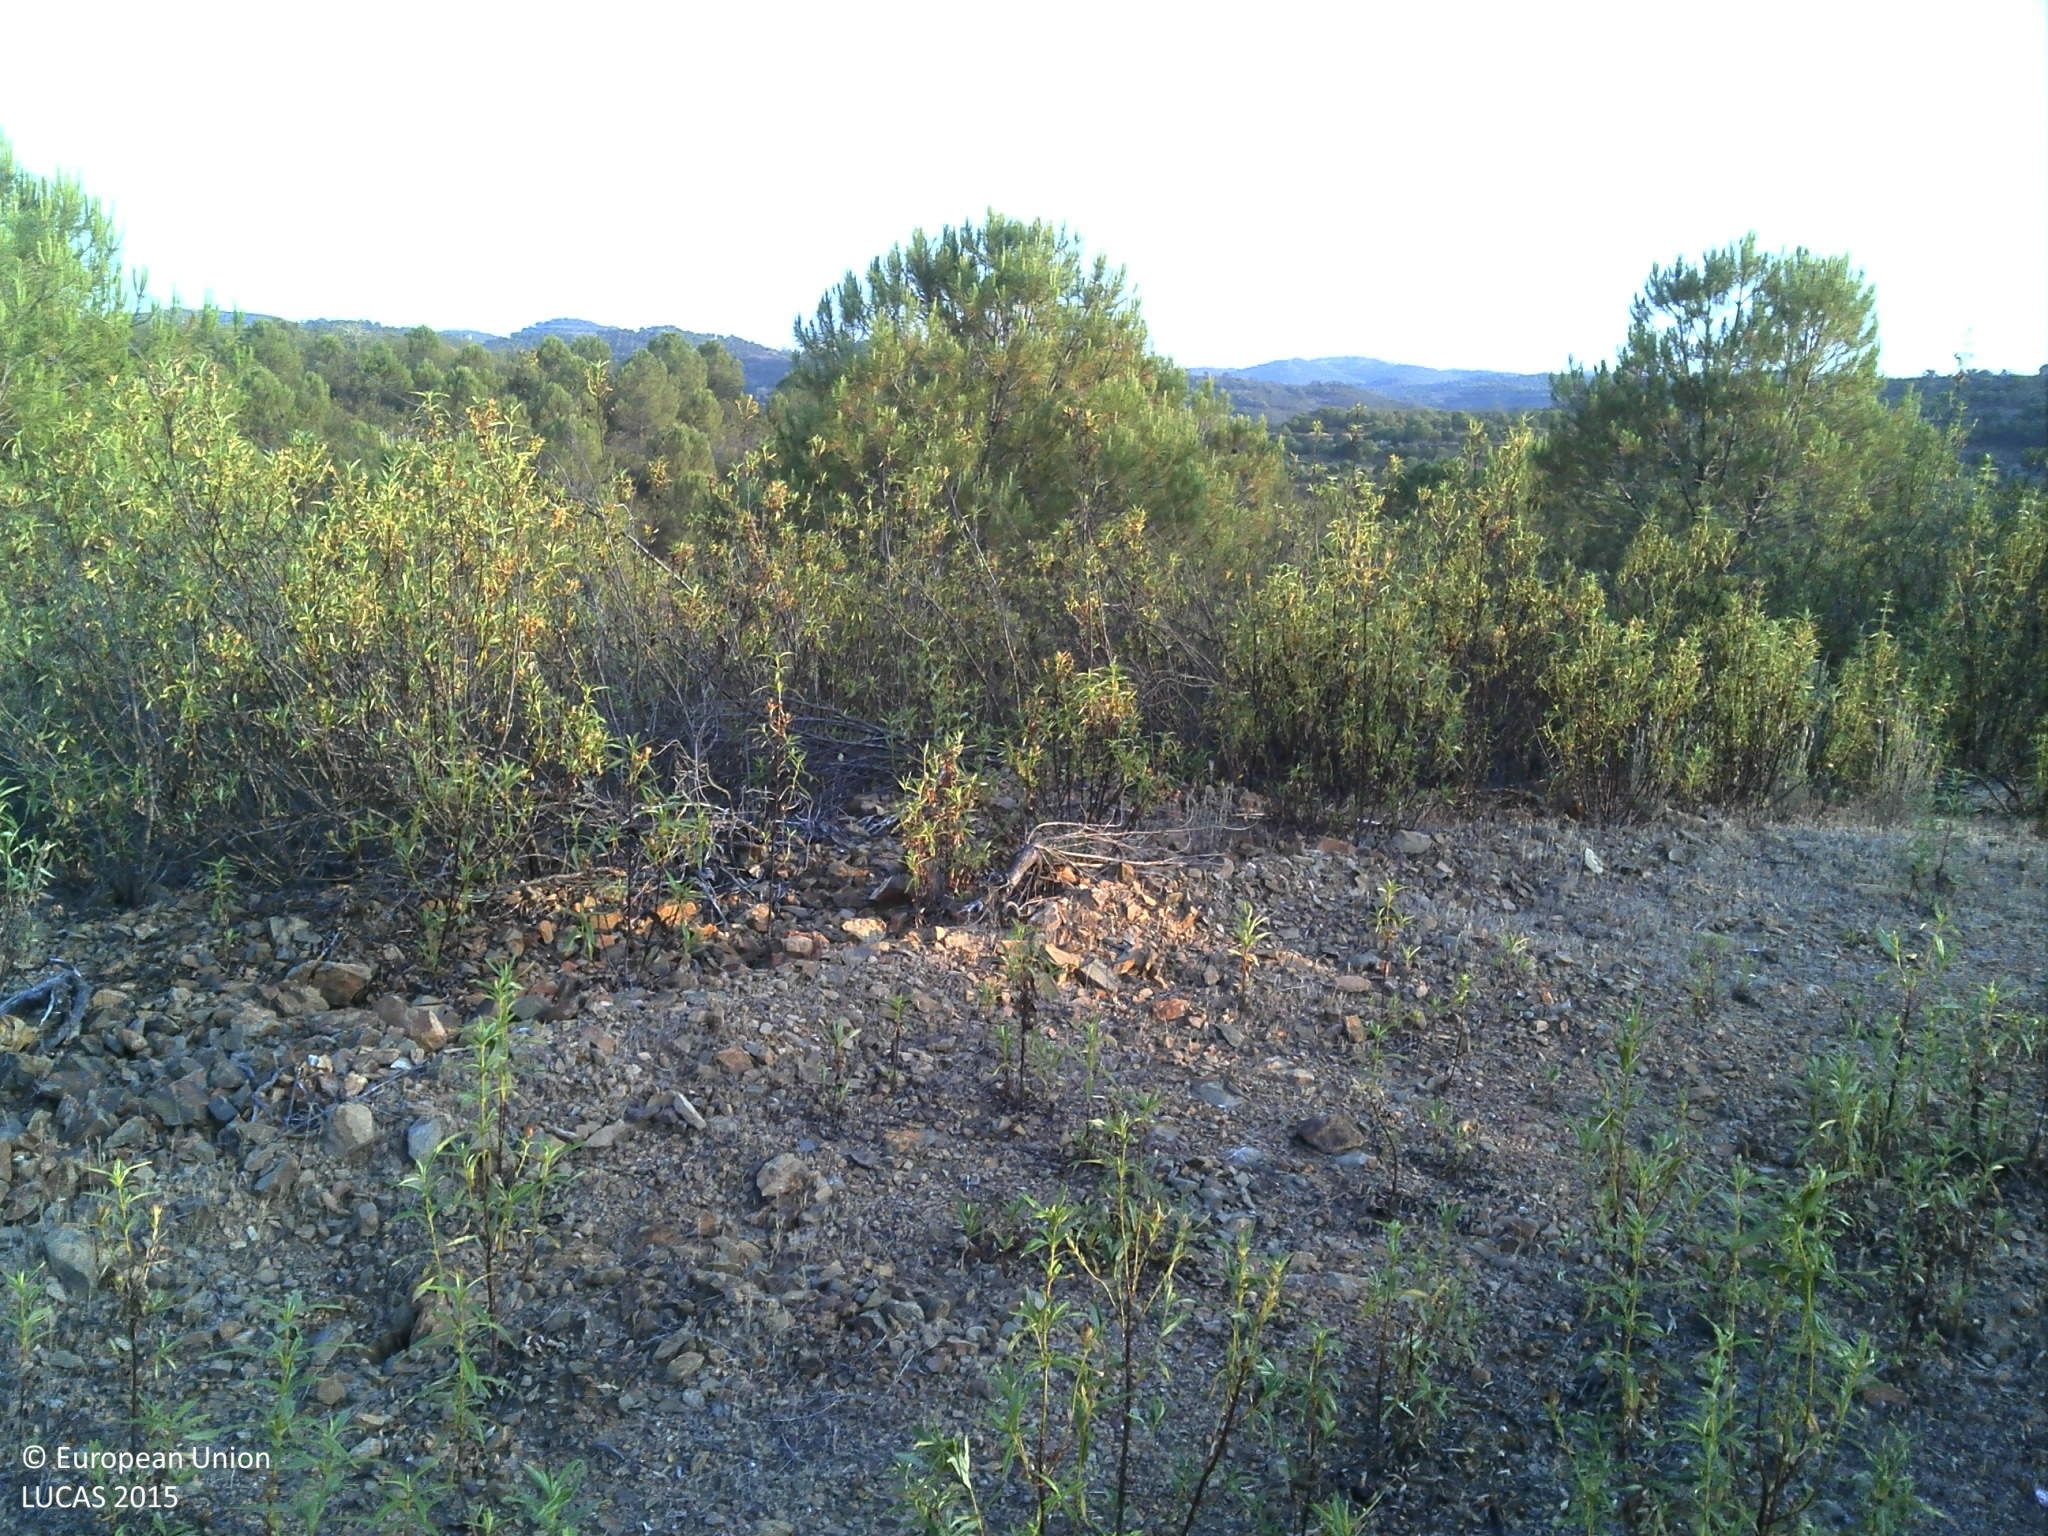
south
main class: Woodland
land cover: Pine dominated coniferous woodland
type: coniferous forest of the mediterranean region
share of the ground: 50 - 75 %
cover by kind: shrubs 65 %, coniferous forest trees 35 %
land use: Forestry
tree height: < 5 m
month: May
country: PT
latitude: 37.3982
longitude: -7.7360
